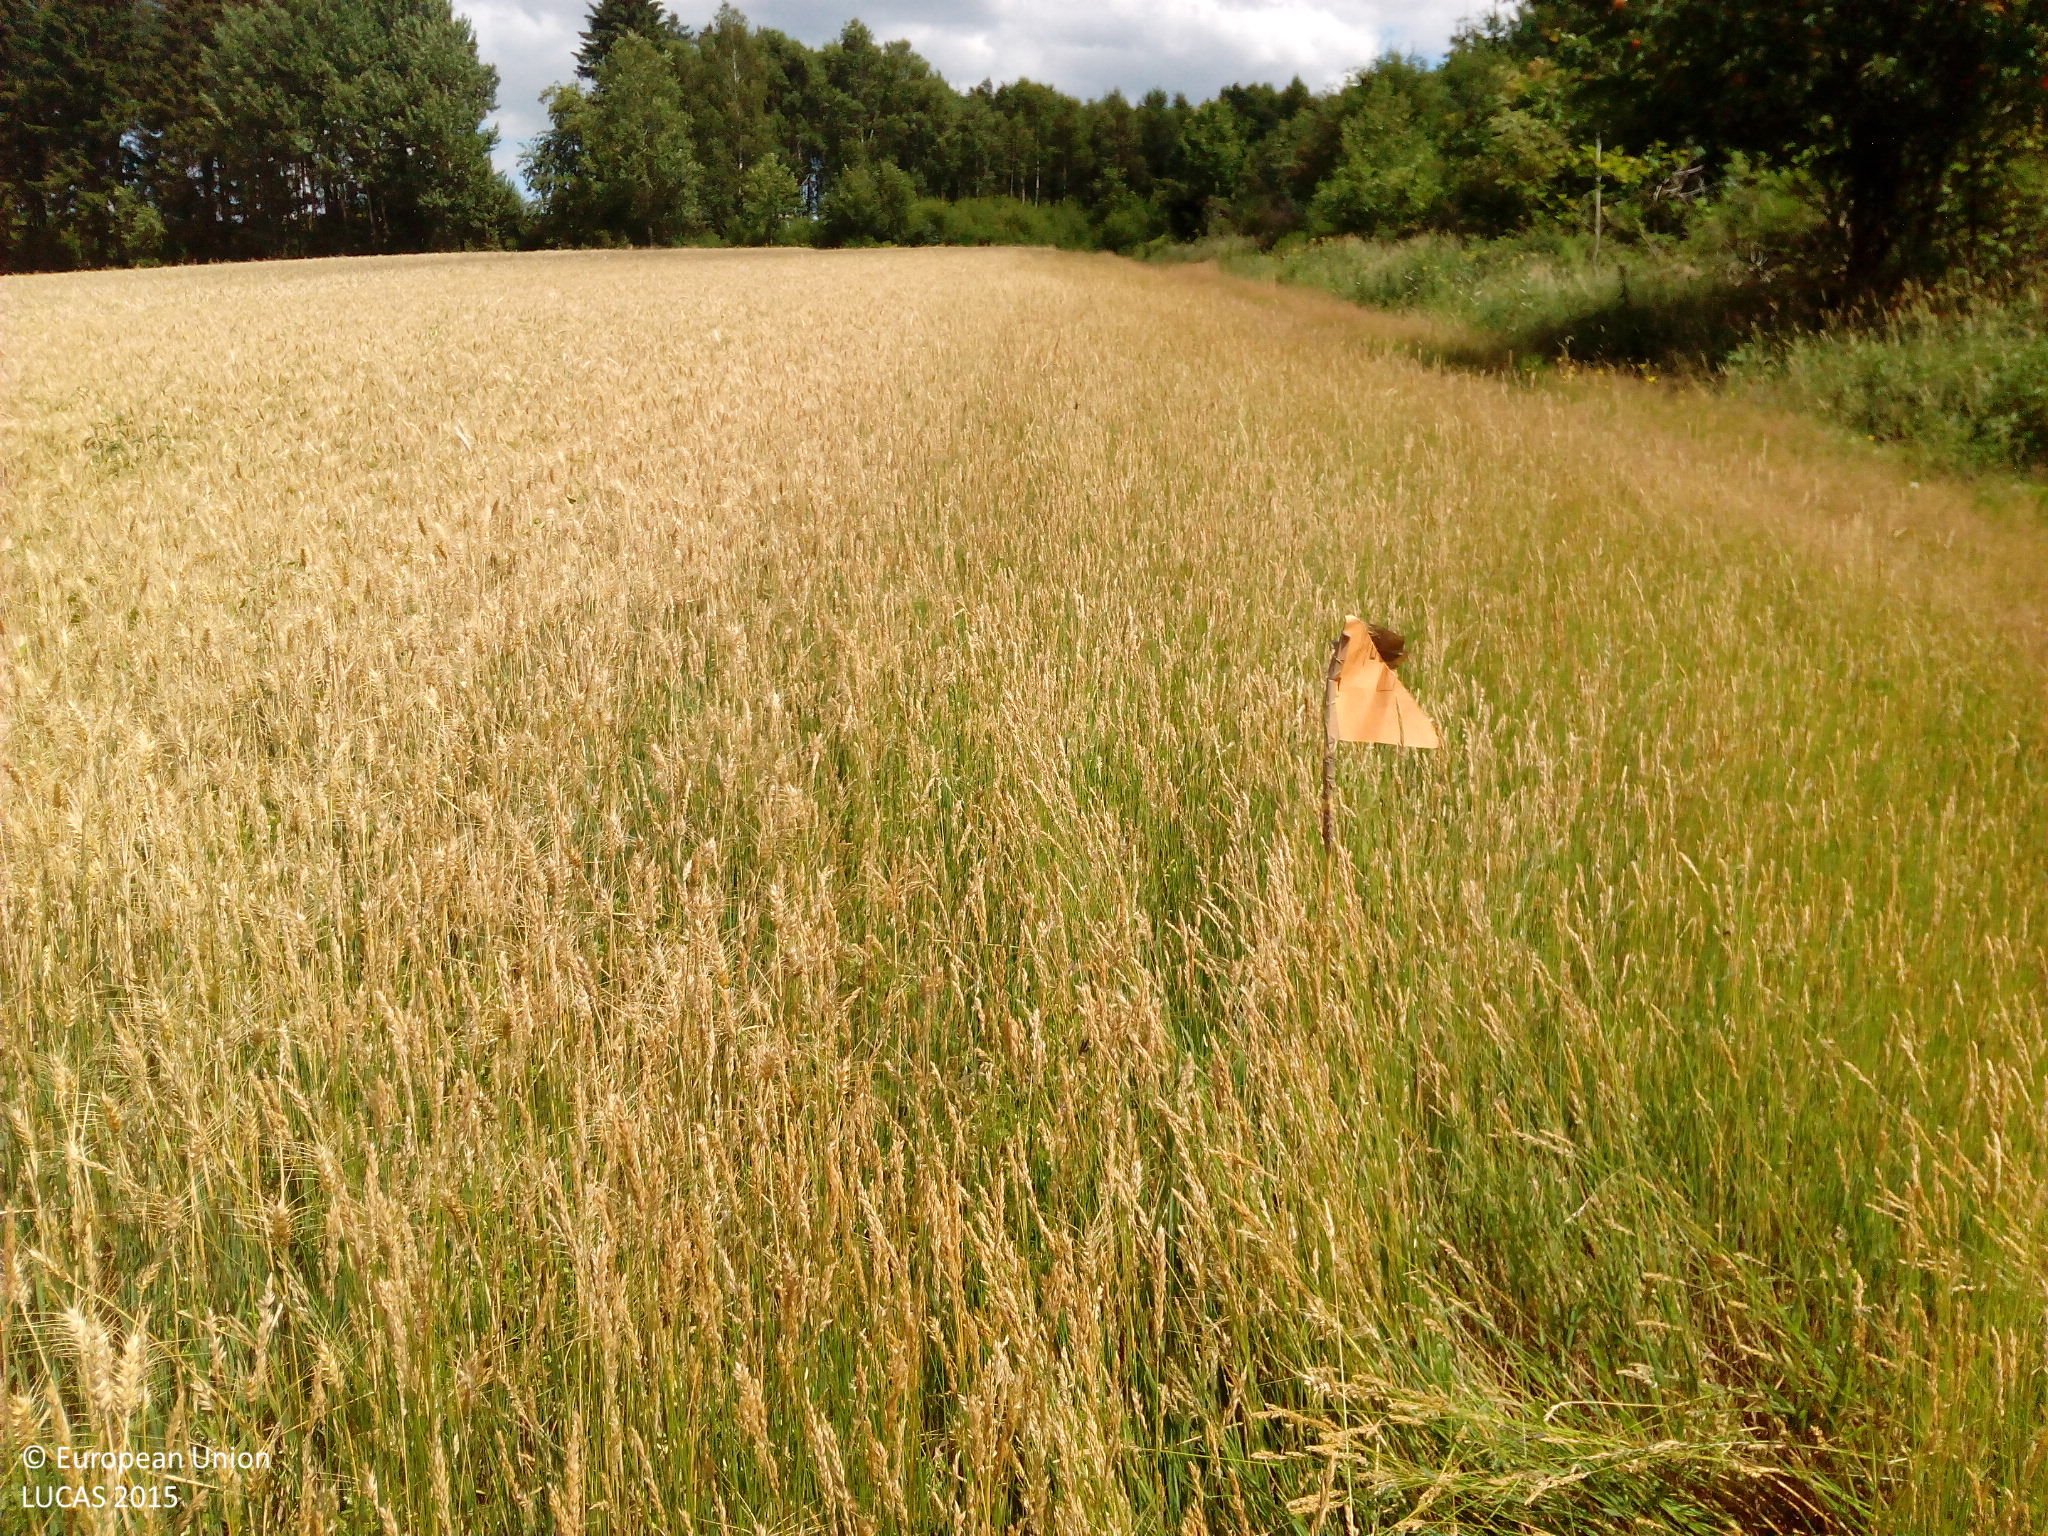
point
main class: Cropland
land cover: Common wheat
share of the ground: > 75 %
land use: Agriculture (excluding fallow land and kitchen gardens)
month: July
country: DE
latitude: 49.8614
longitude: 7.1763
